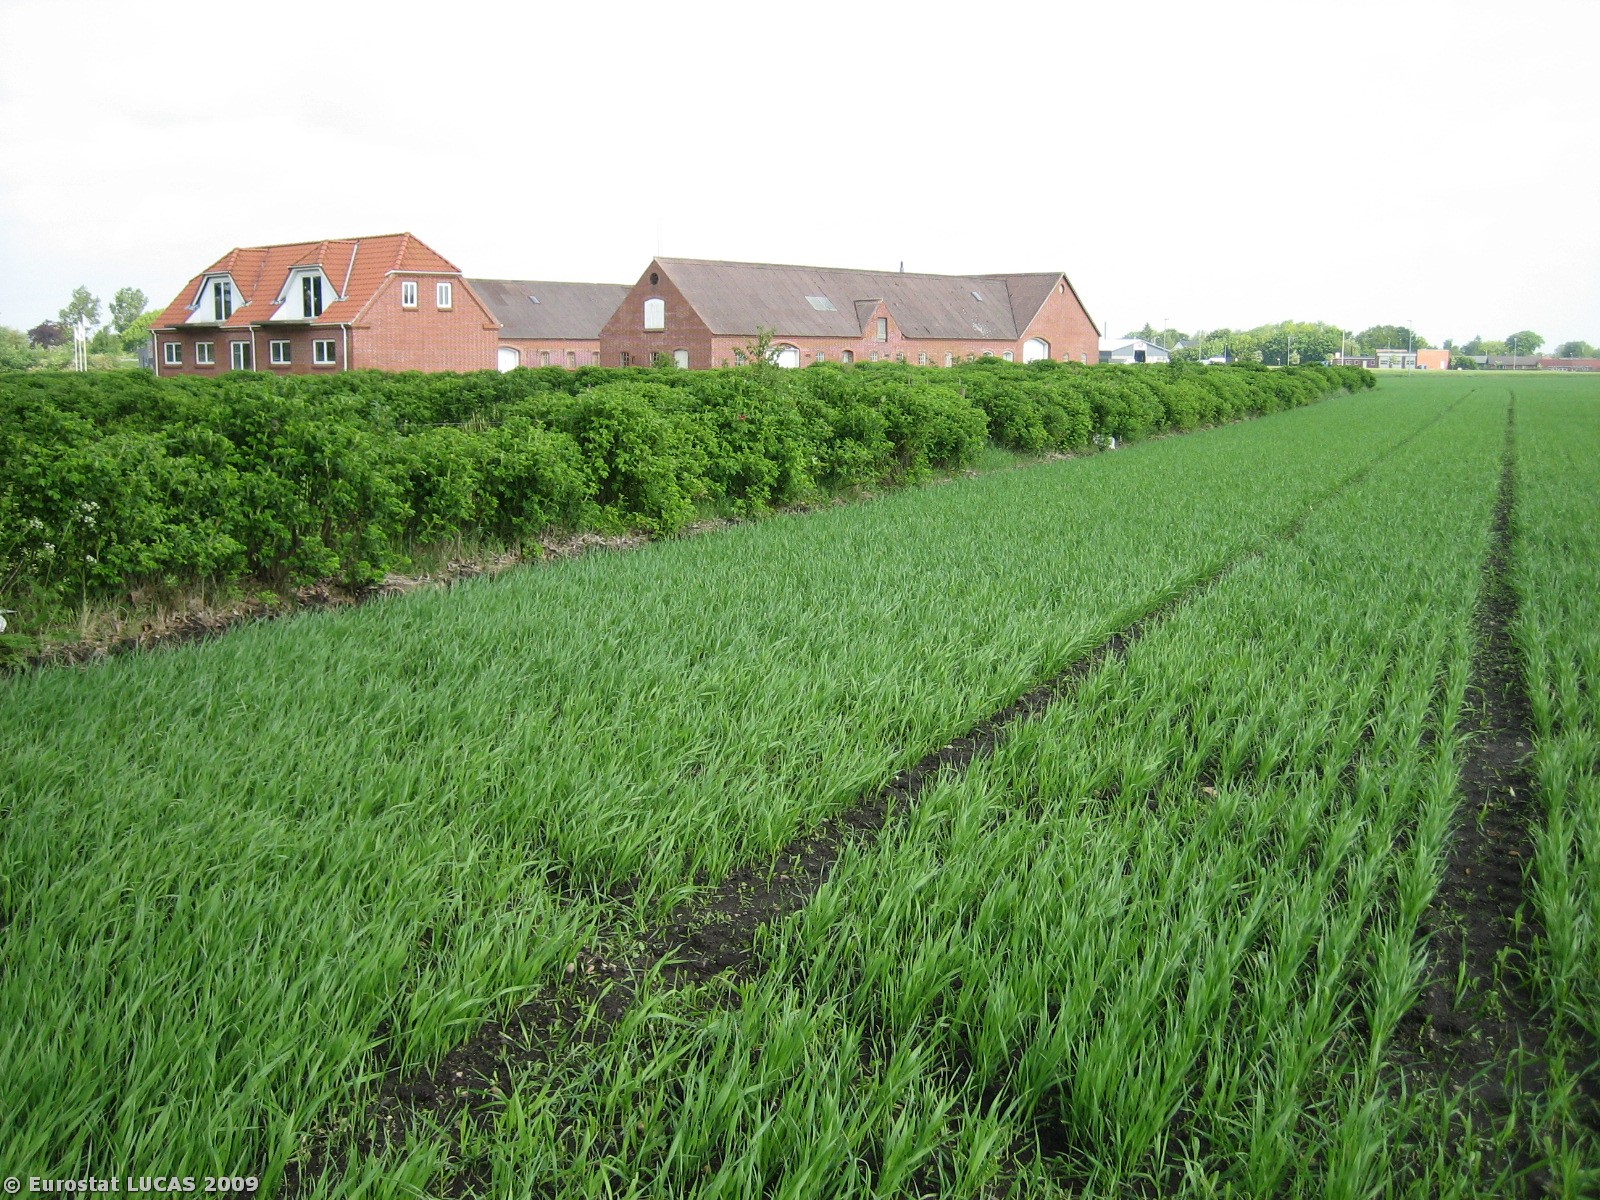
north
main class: Cropland
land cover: Oats
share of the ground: > 75 %
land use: Agriculture (excluding fallow land and kitchen gardens)
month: May
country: DK
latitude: 56.2540
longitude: 8.7909
